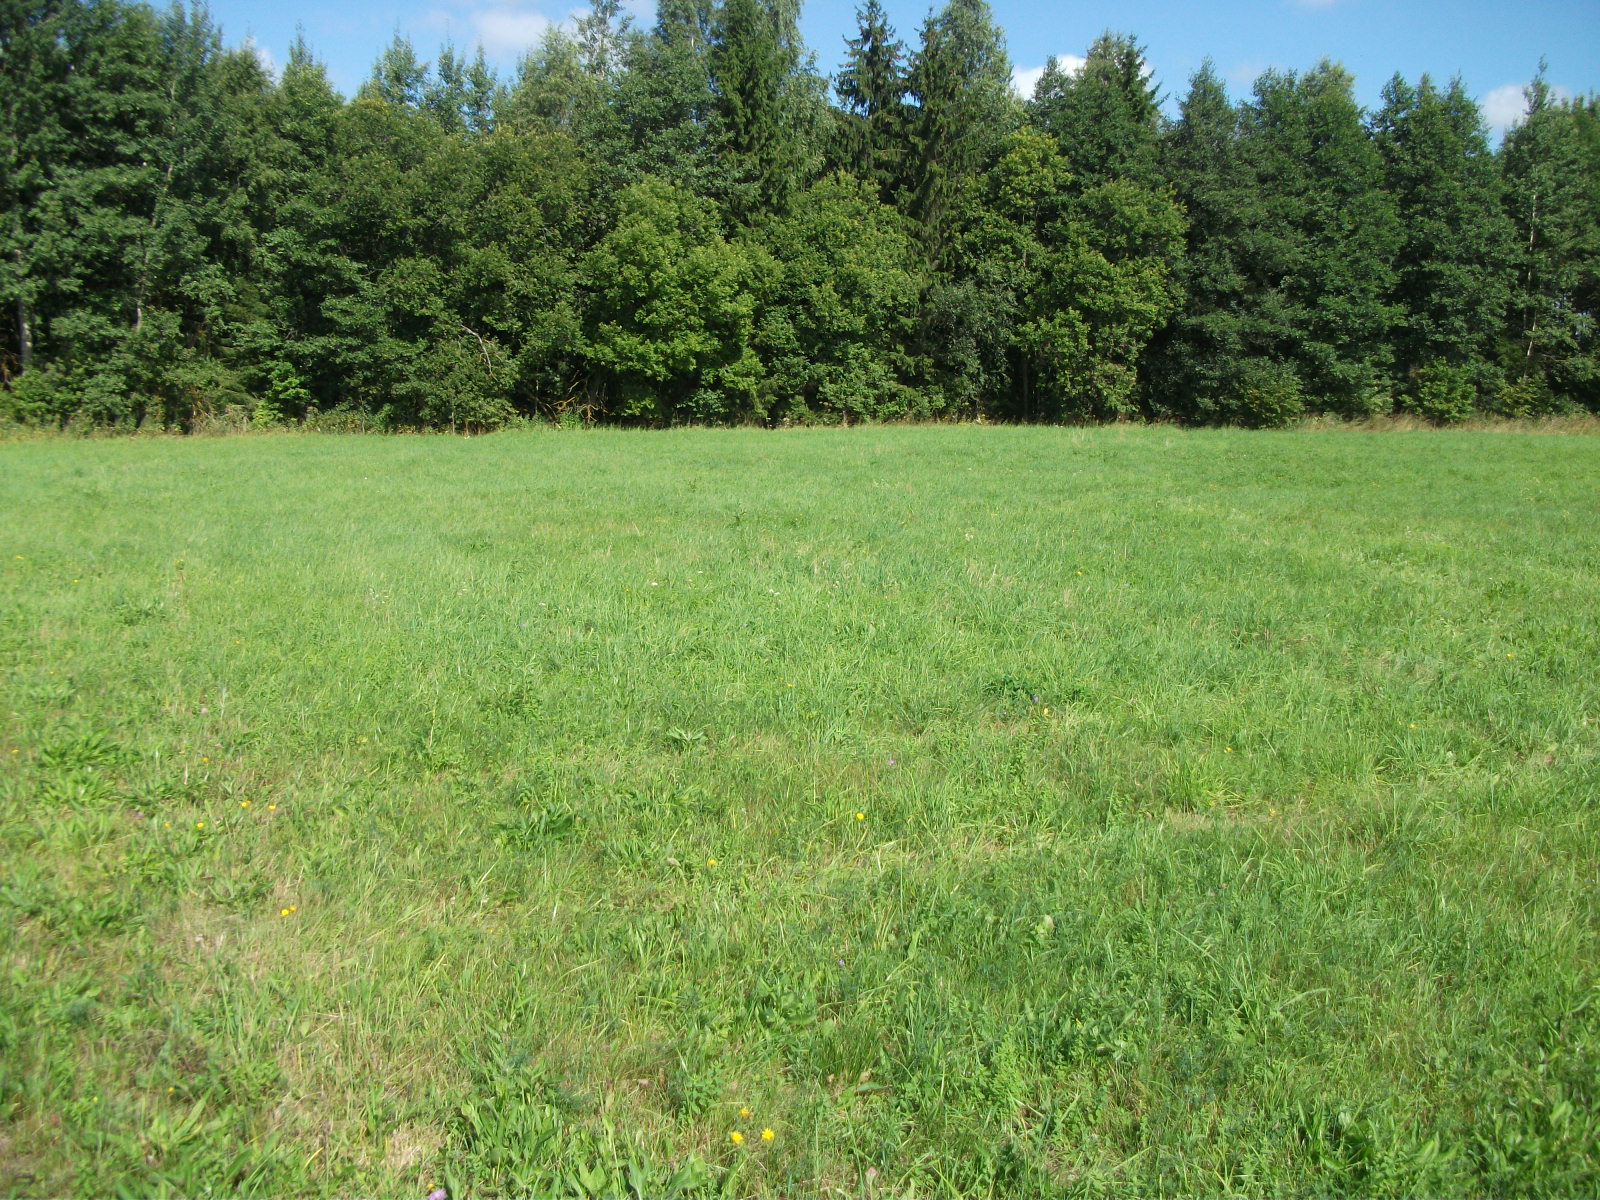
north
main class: Grassland
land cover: Grassland without tree/shrub cover
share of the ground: > 75 %
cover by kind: herbaceous plants 100 %
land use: Agriculture (excluding fallow land and kitchen gardens)
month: August
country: LV
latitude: 56.4443
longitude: 26.4158
